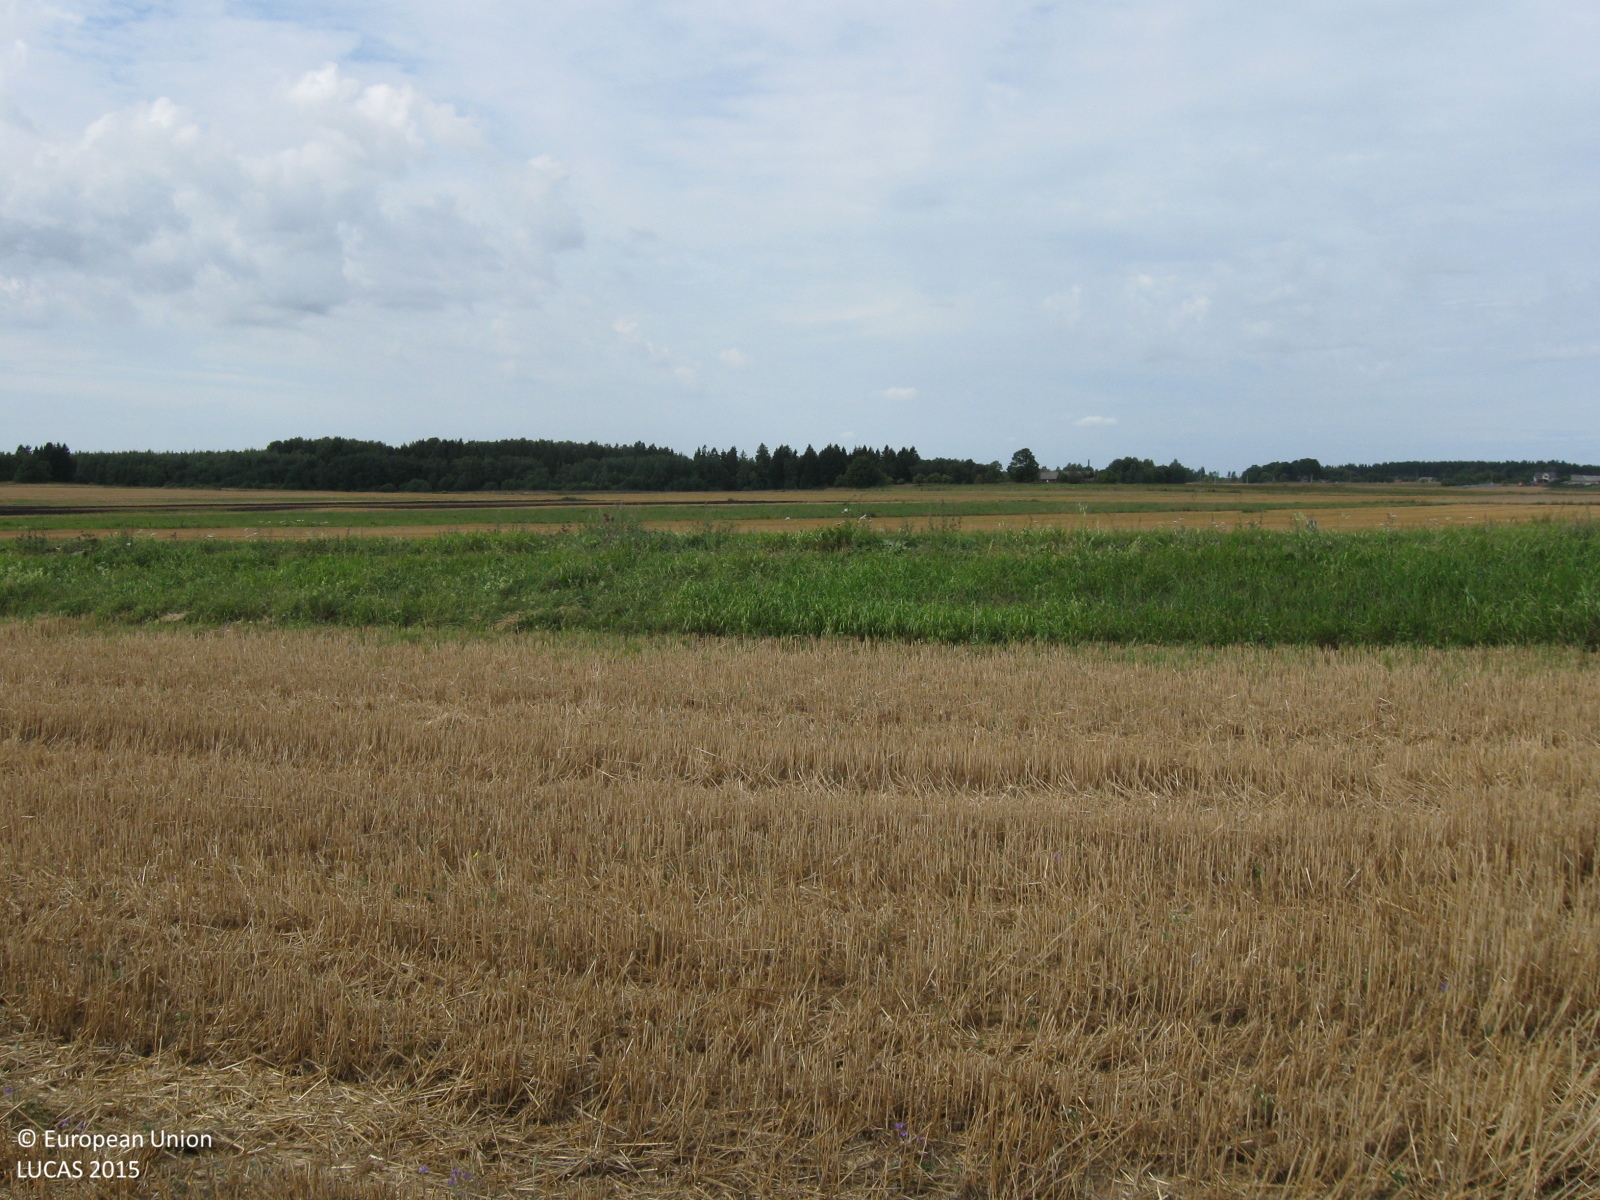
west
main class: Cropland
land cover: Common wheat
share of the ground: > 75 %
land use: Agriculture (excluding fallow land and kitchen gardens)
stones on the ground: < 10 %
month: August
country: LT
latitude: 55.6222
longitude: 23.2705
